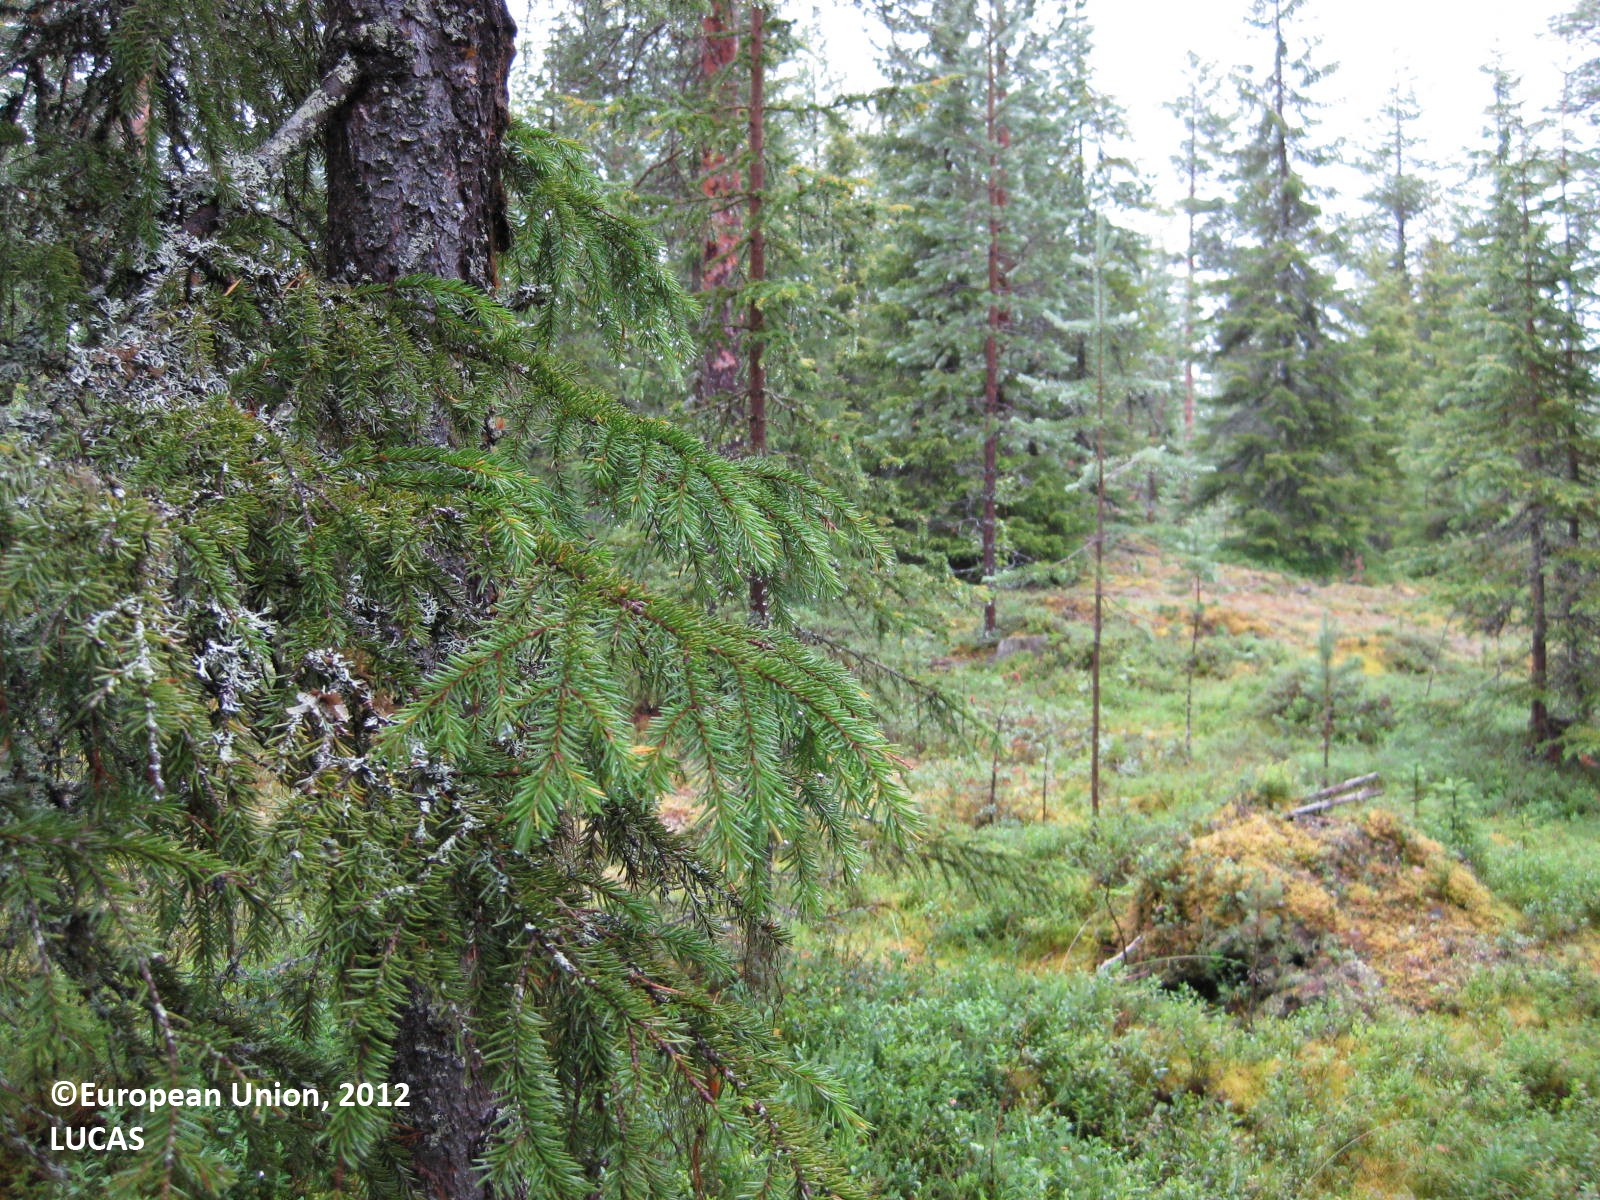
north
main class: Woodland
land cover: Other coniferous woodland
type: boreal forest
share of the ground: 50 - 75 %
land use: Forestry
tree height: > 5 m
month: August
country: FI
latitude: 65.8291
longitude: 28.0676
